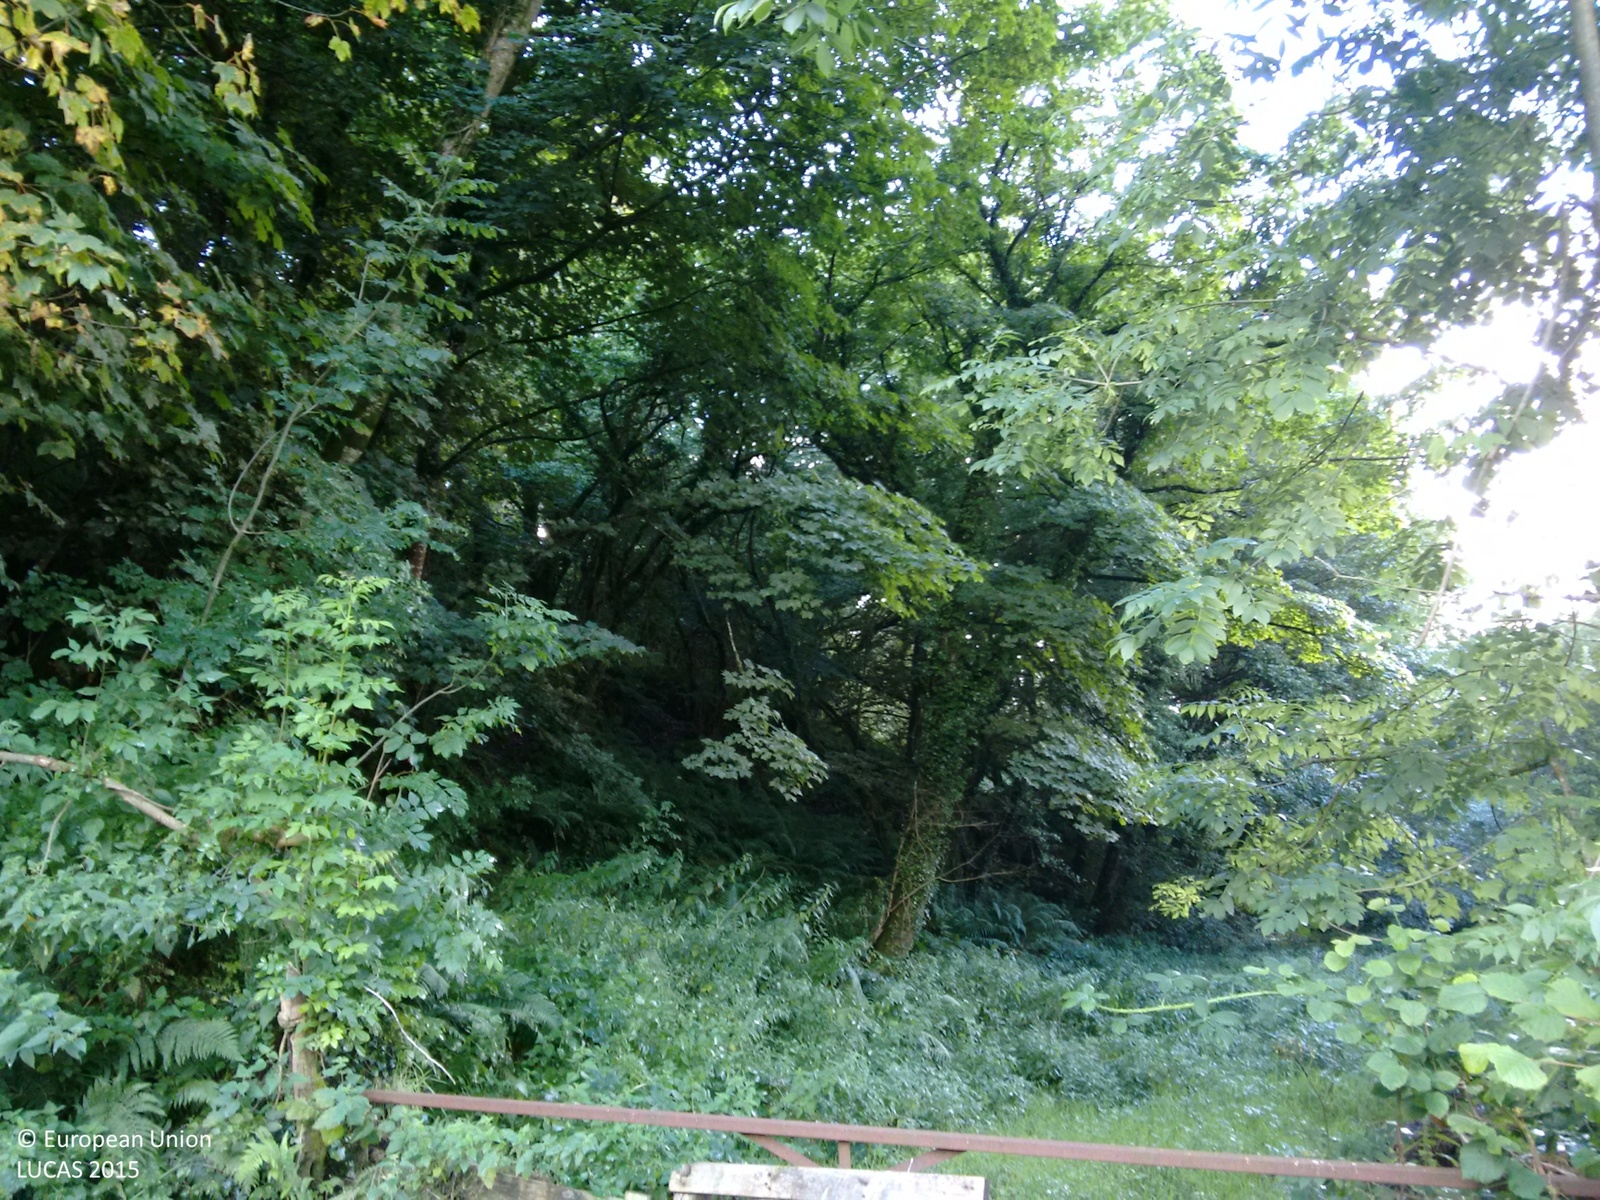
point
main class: Woodland
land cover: Broadleaved woodland
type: mesophytic deciduous forest
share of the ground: > 75 %
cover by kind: broadleaved forest trees 80 %, shrubs 20 %
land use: Semi-natural and natural areas not in use
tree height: > 5 m
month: August
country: GB
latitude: 51.9936
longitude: -4.9267
